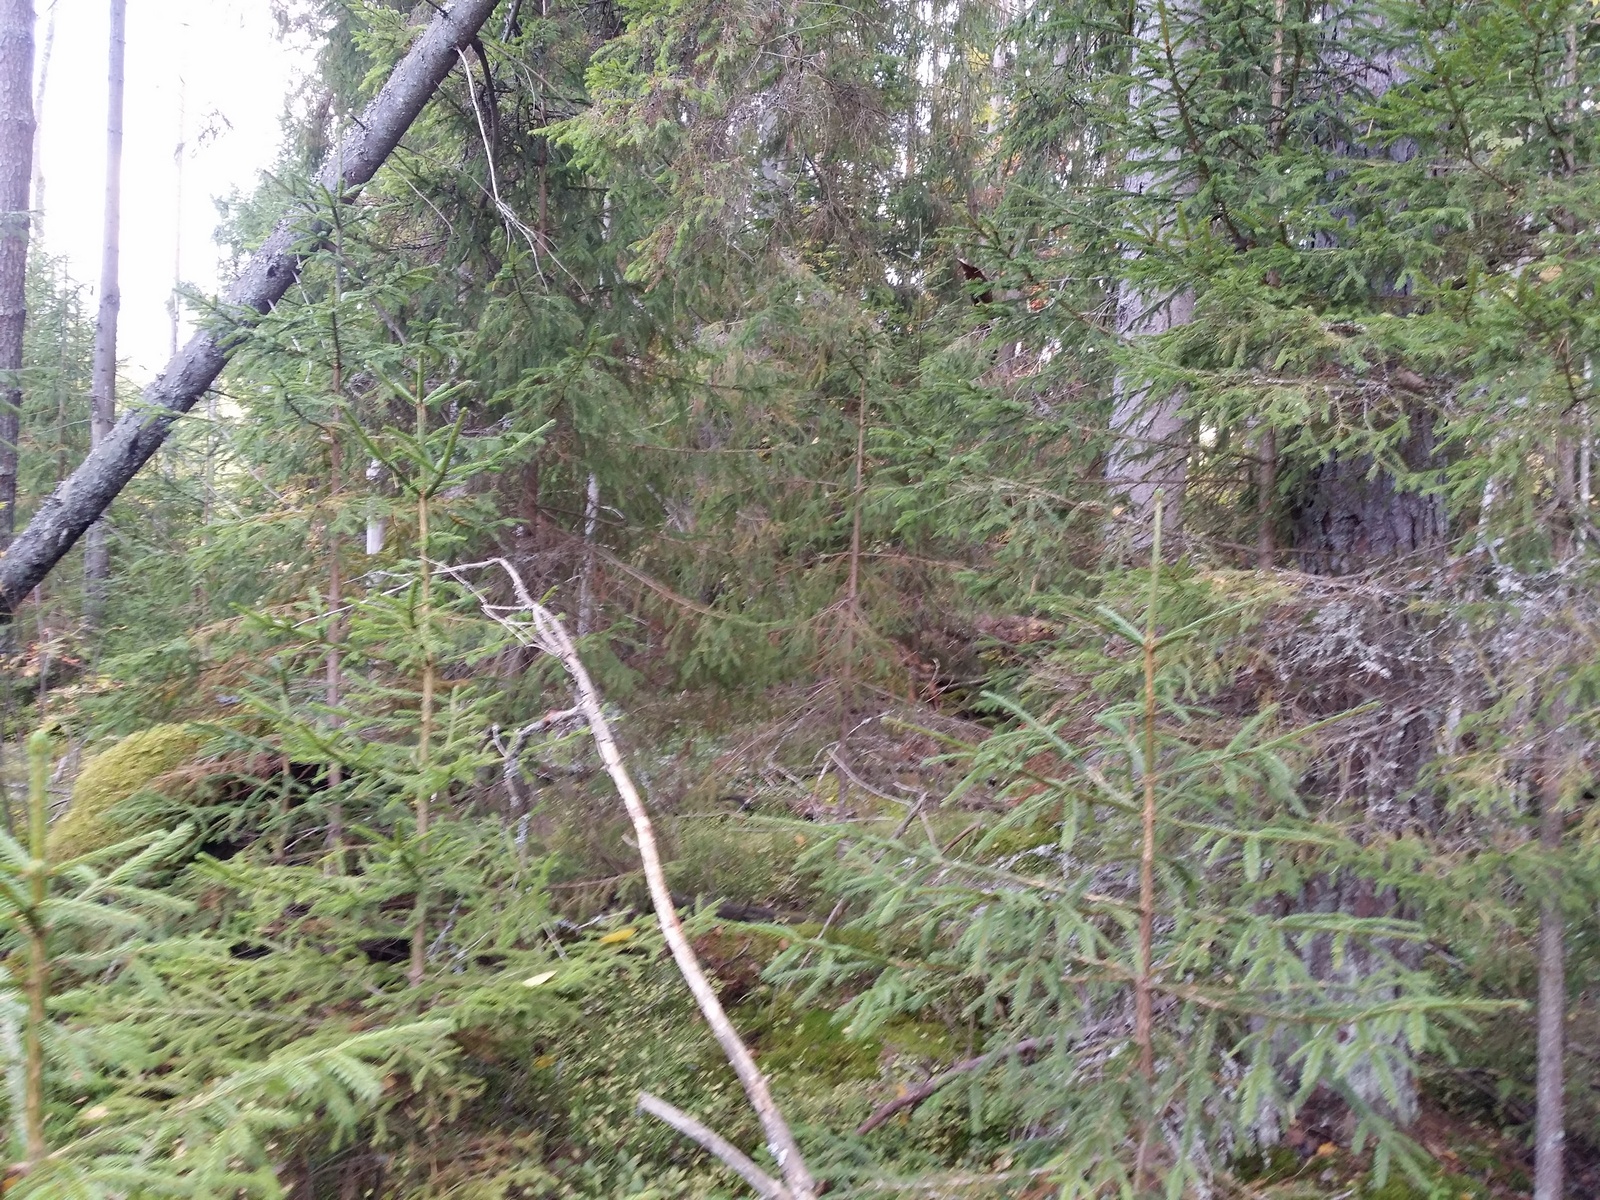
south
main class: Woodland
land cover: Other coniferous woodland
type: hemiboreal forest and nemoral coniferous forest and mixed broadleaved-coniferous forest
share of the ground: > 75 %
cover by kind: coniferous forest trees 80 %, lichens and mosses 15 %, broadleaved forest trees 5 %
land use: Forestry
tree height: > 5 m
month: September
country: LV
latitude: 57.4033
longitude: 27.3968
